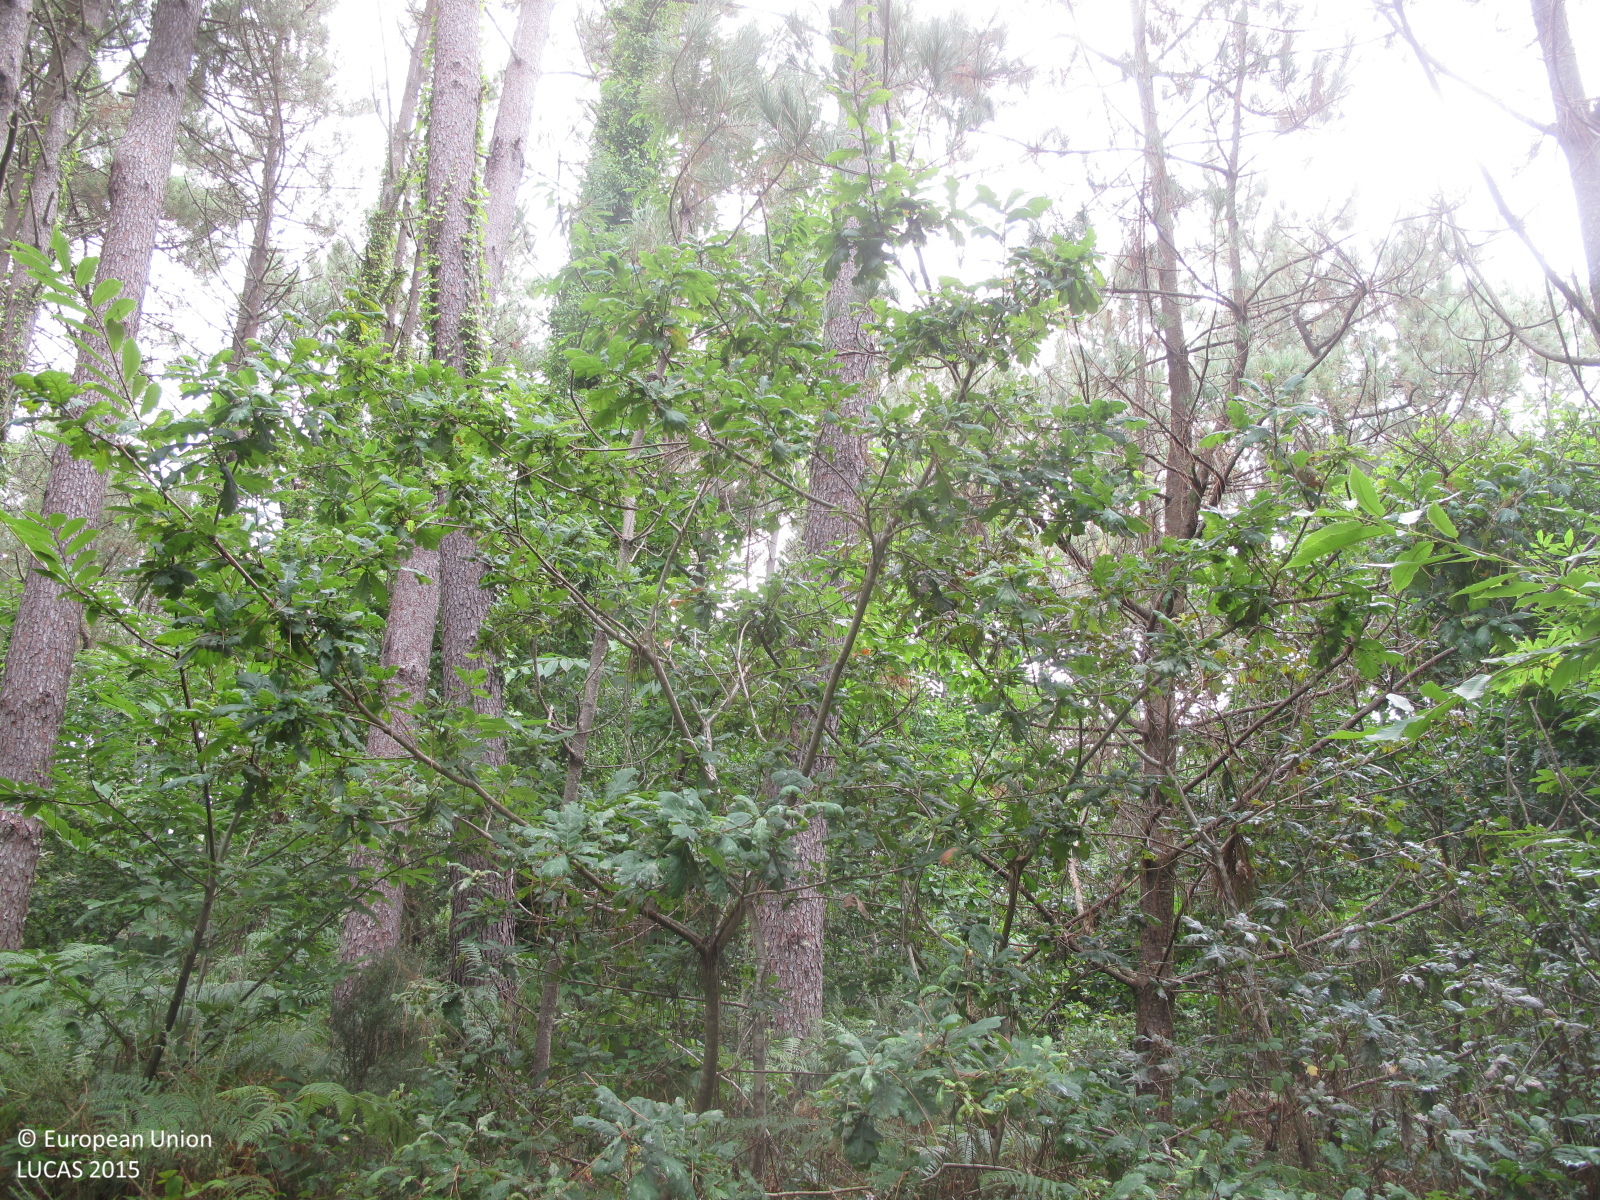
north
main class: Woodland
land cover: Pine dominated mixed woodland
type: hemiboreal forest and nemoral coniferous forest and mixed broadleaved-coniferous forest
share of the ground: 50 - 75 %
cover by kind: coniferous forest trees 40 %, shrubs 30 %, broadleaved forest trees 20 %, herbaceous plants 10 %
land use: Forestry
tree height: > 5 m
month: July
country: ES
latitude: 42.9941
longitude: -9.2262
